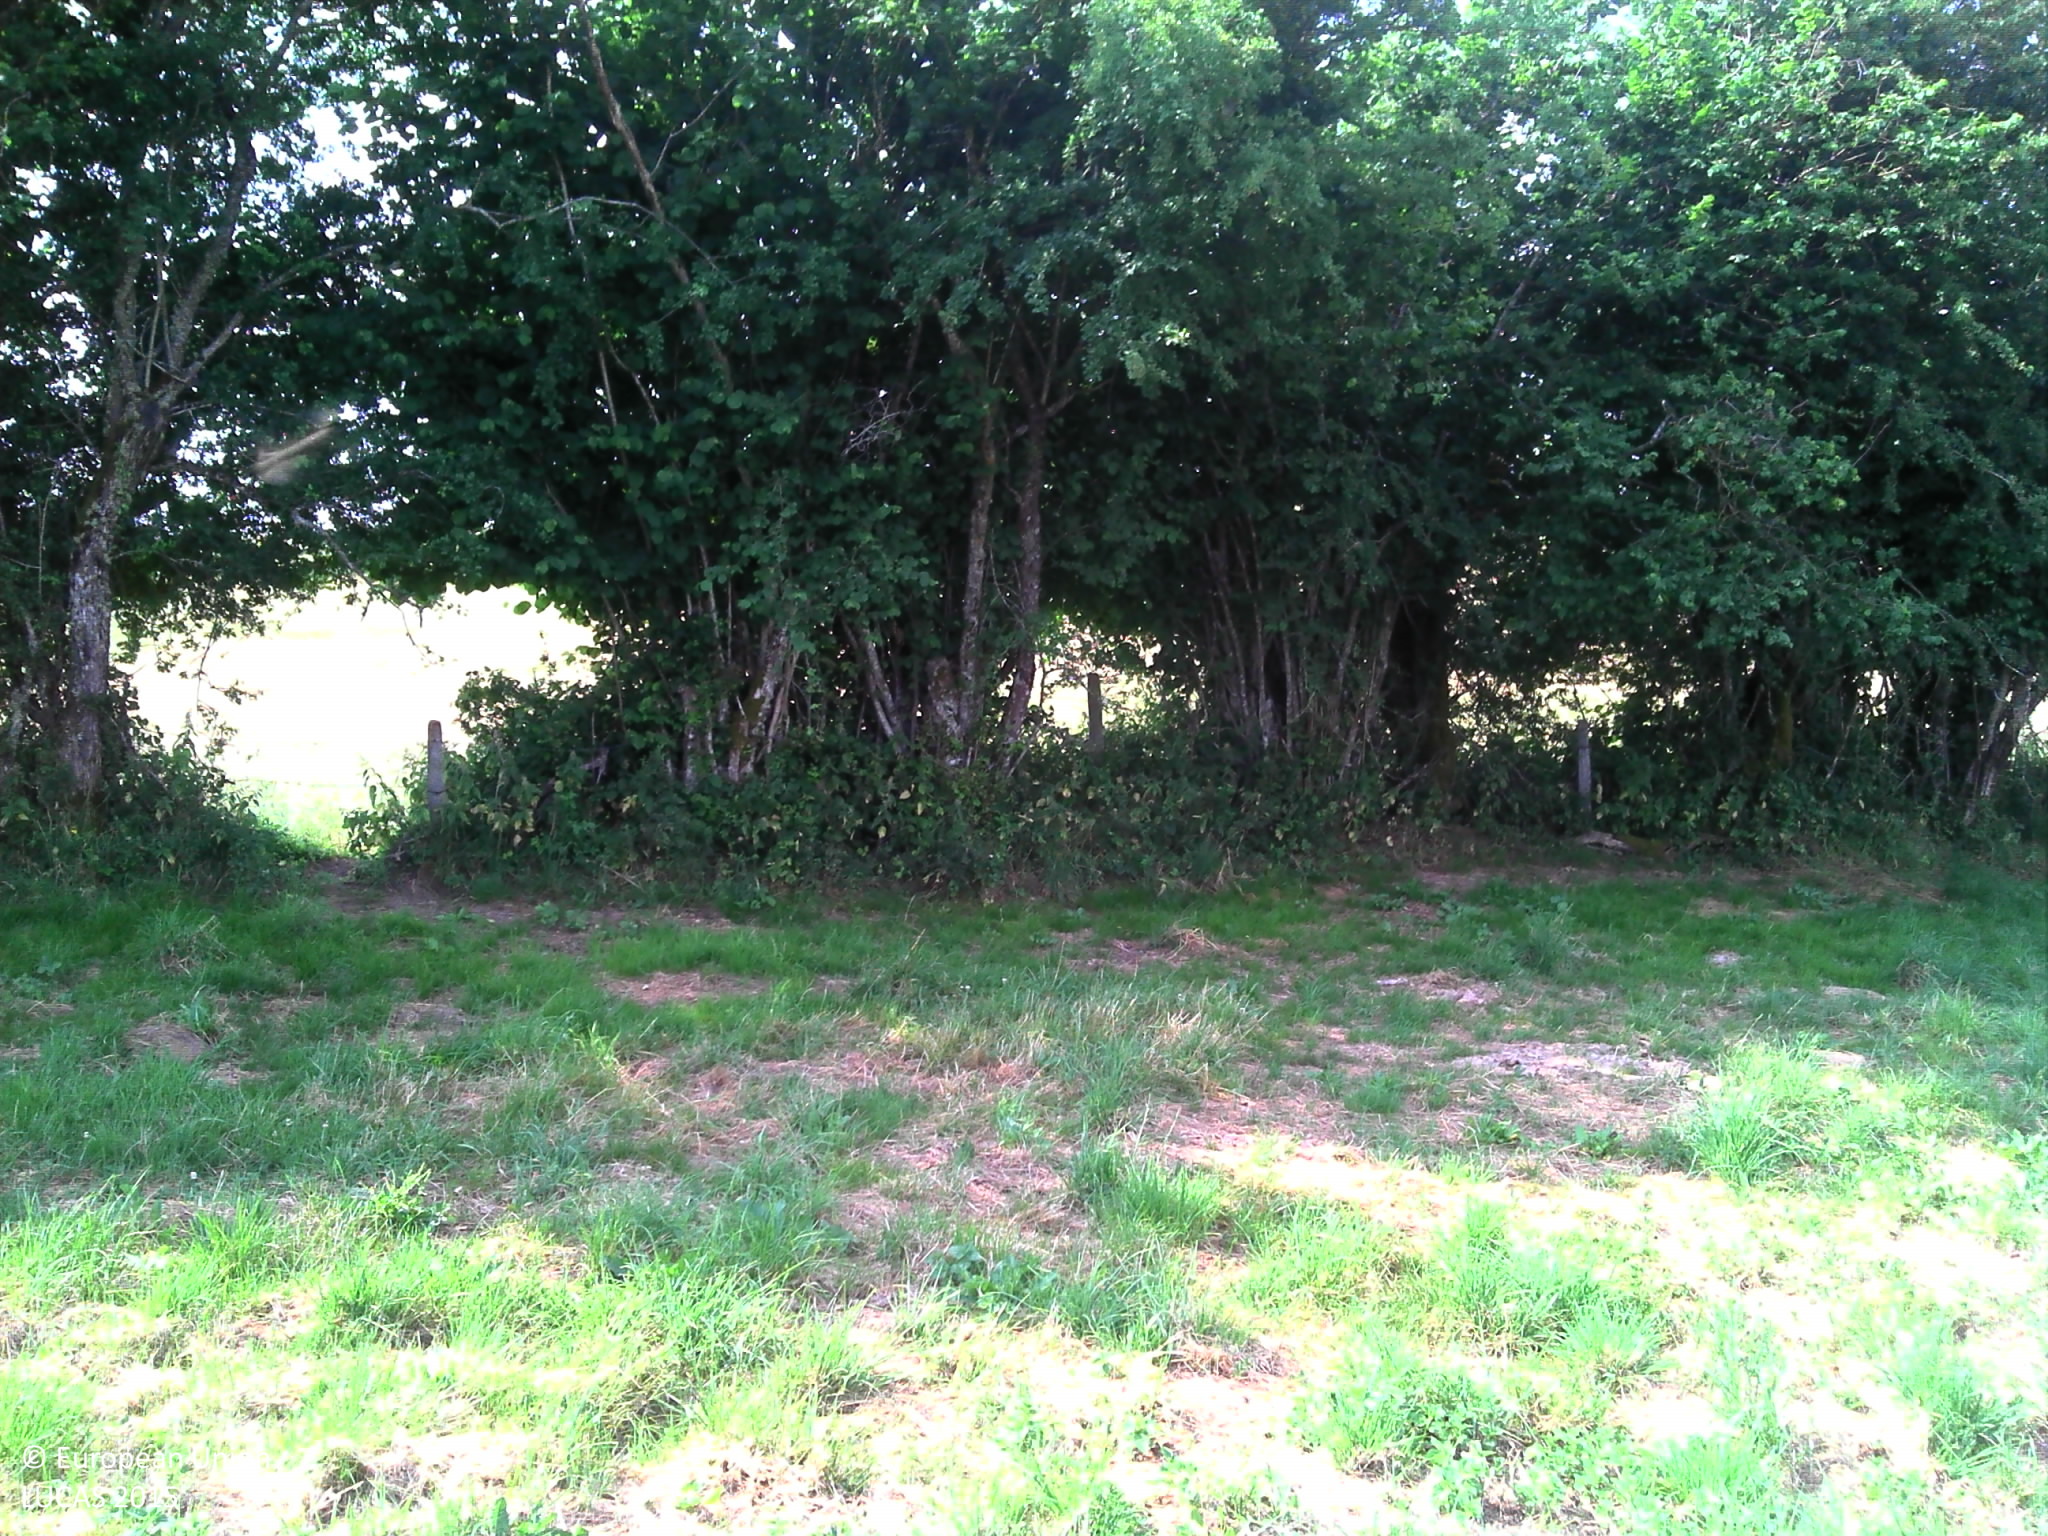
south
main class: Grassland
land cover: Grassland without tree/shrub cover
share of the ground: > 75 %
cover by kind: herbaceous plants 100 %
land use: Agriculture (excluding fallow land and kitchen gardens)
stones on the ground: < 10 %
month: July
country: FR
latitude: 44.8528
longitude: 2.9545
